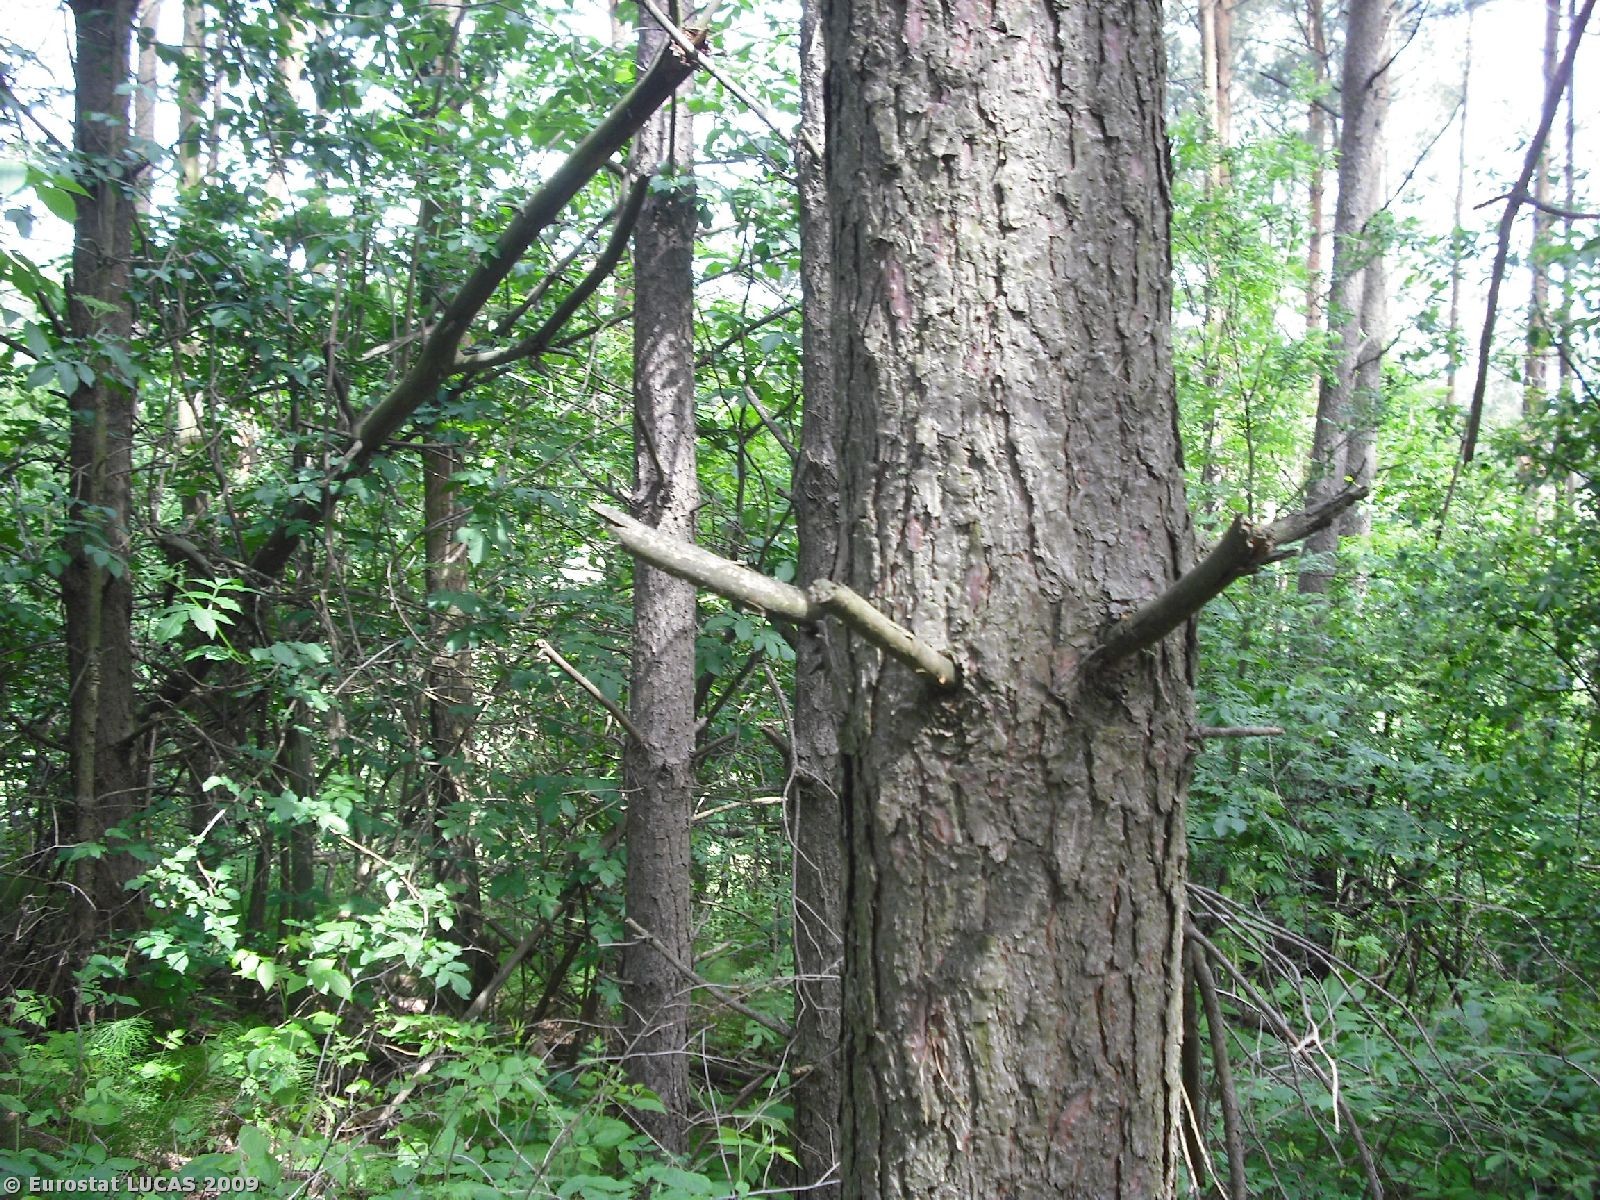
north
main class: Woodland
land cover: Coniferous woodland
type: hemiboreal forest and nemoral coniferous forest and mixed broadleaved-coniferous forest
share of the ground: > 75 %
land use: Forestry
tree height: > 5 m
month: June
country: PL
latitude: 54.2614
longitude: 22.8587
